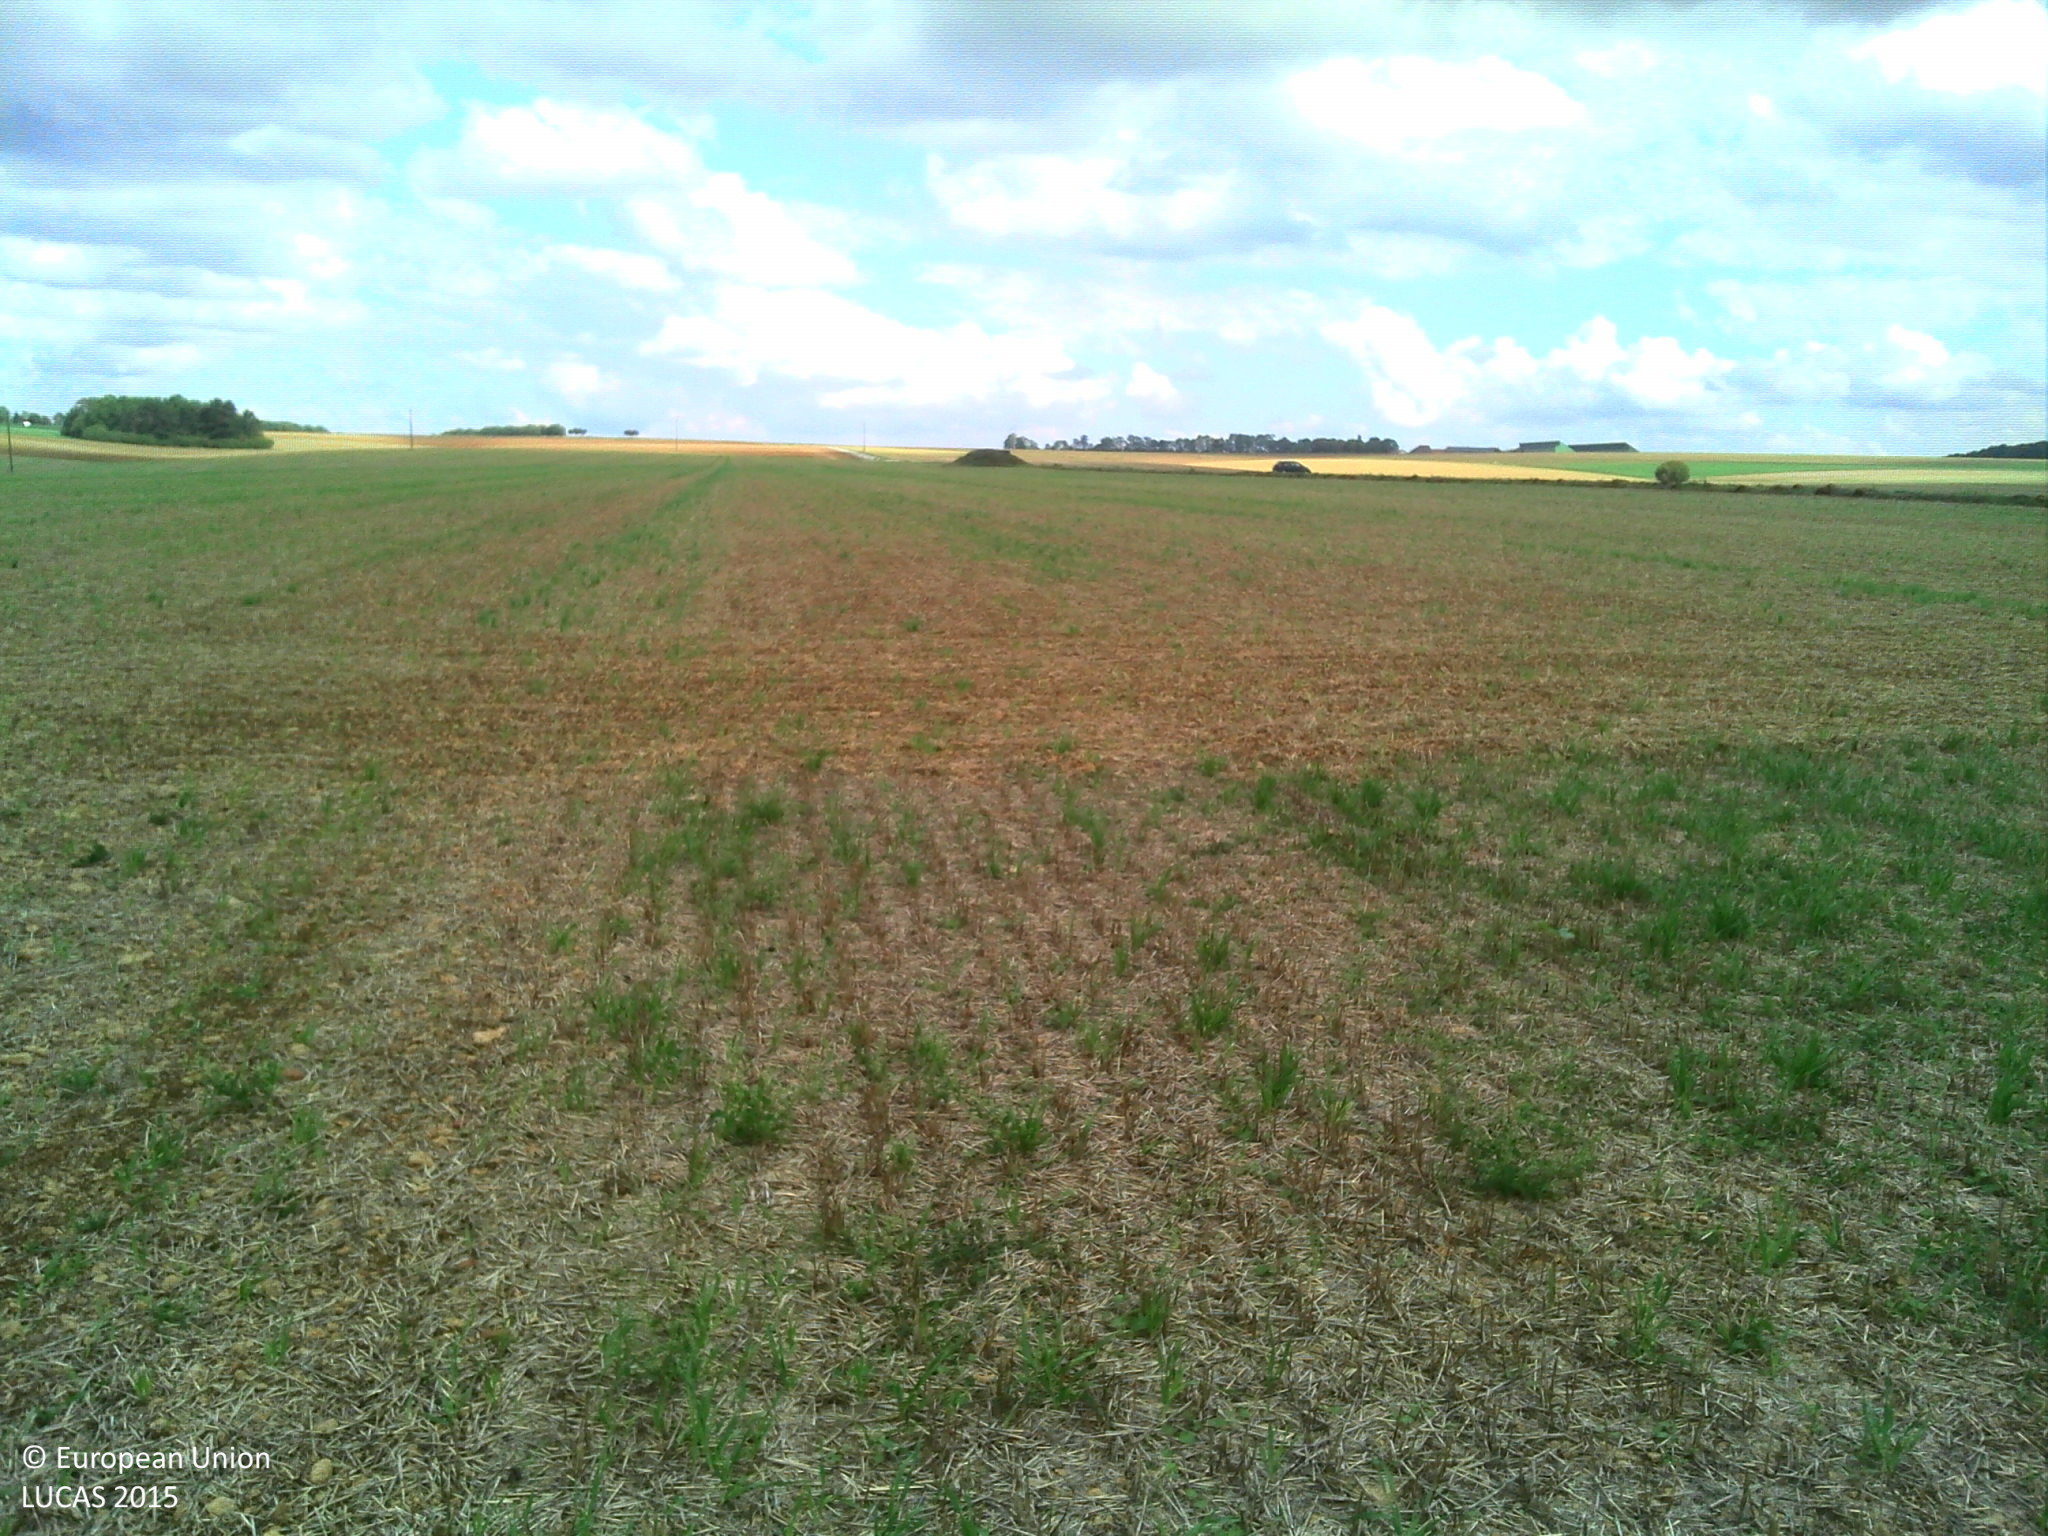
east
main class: Cropland
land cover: Common wheat
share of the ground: > 75 %
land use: Agriculture (excluding fallow land and kitchen gardens)
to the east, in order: Common wheat
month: September
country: FR
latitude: 49.1222
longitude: 5.9572
